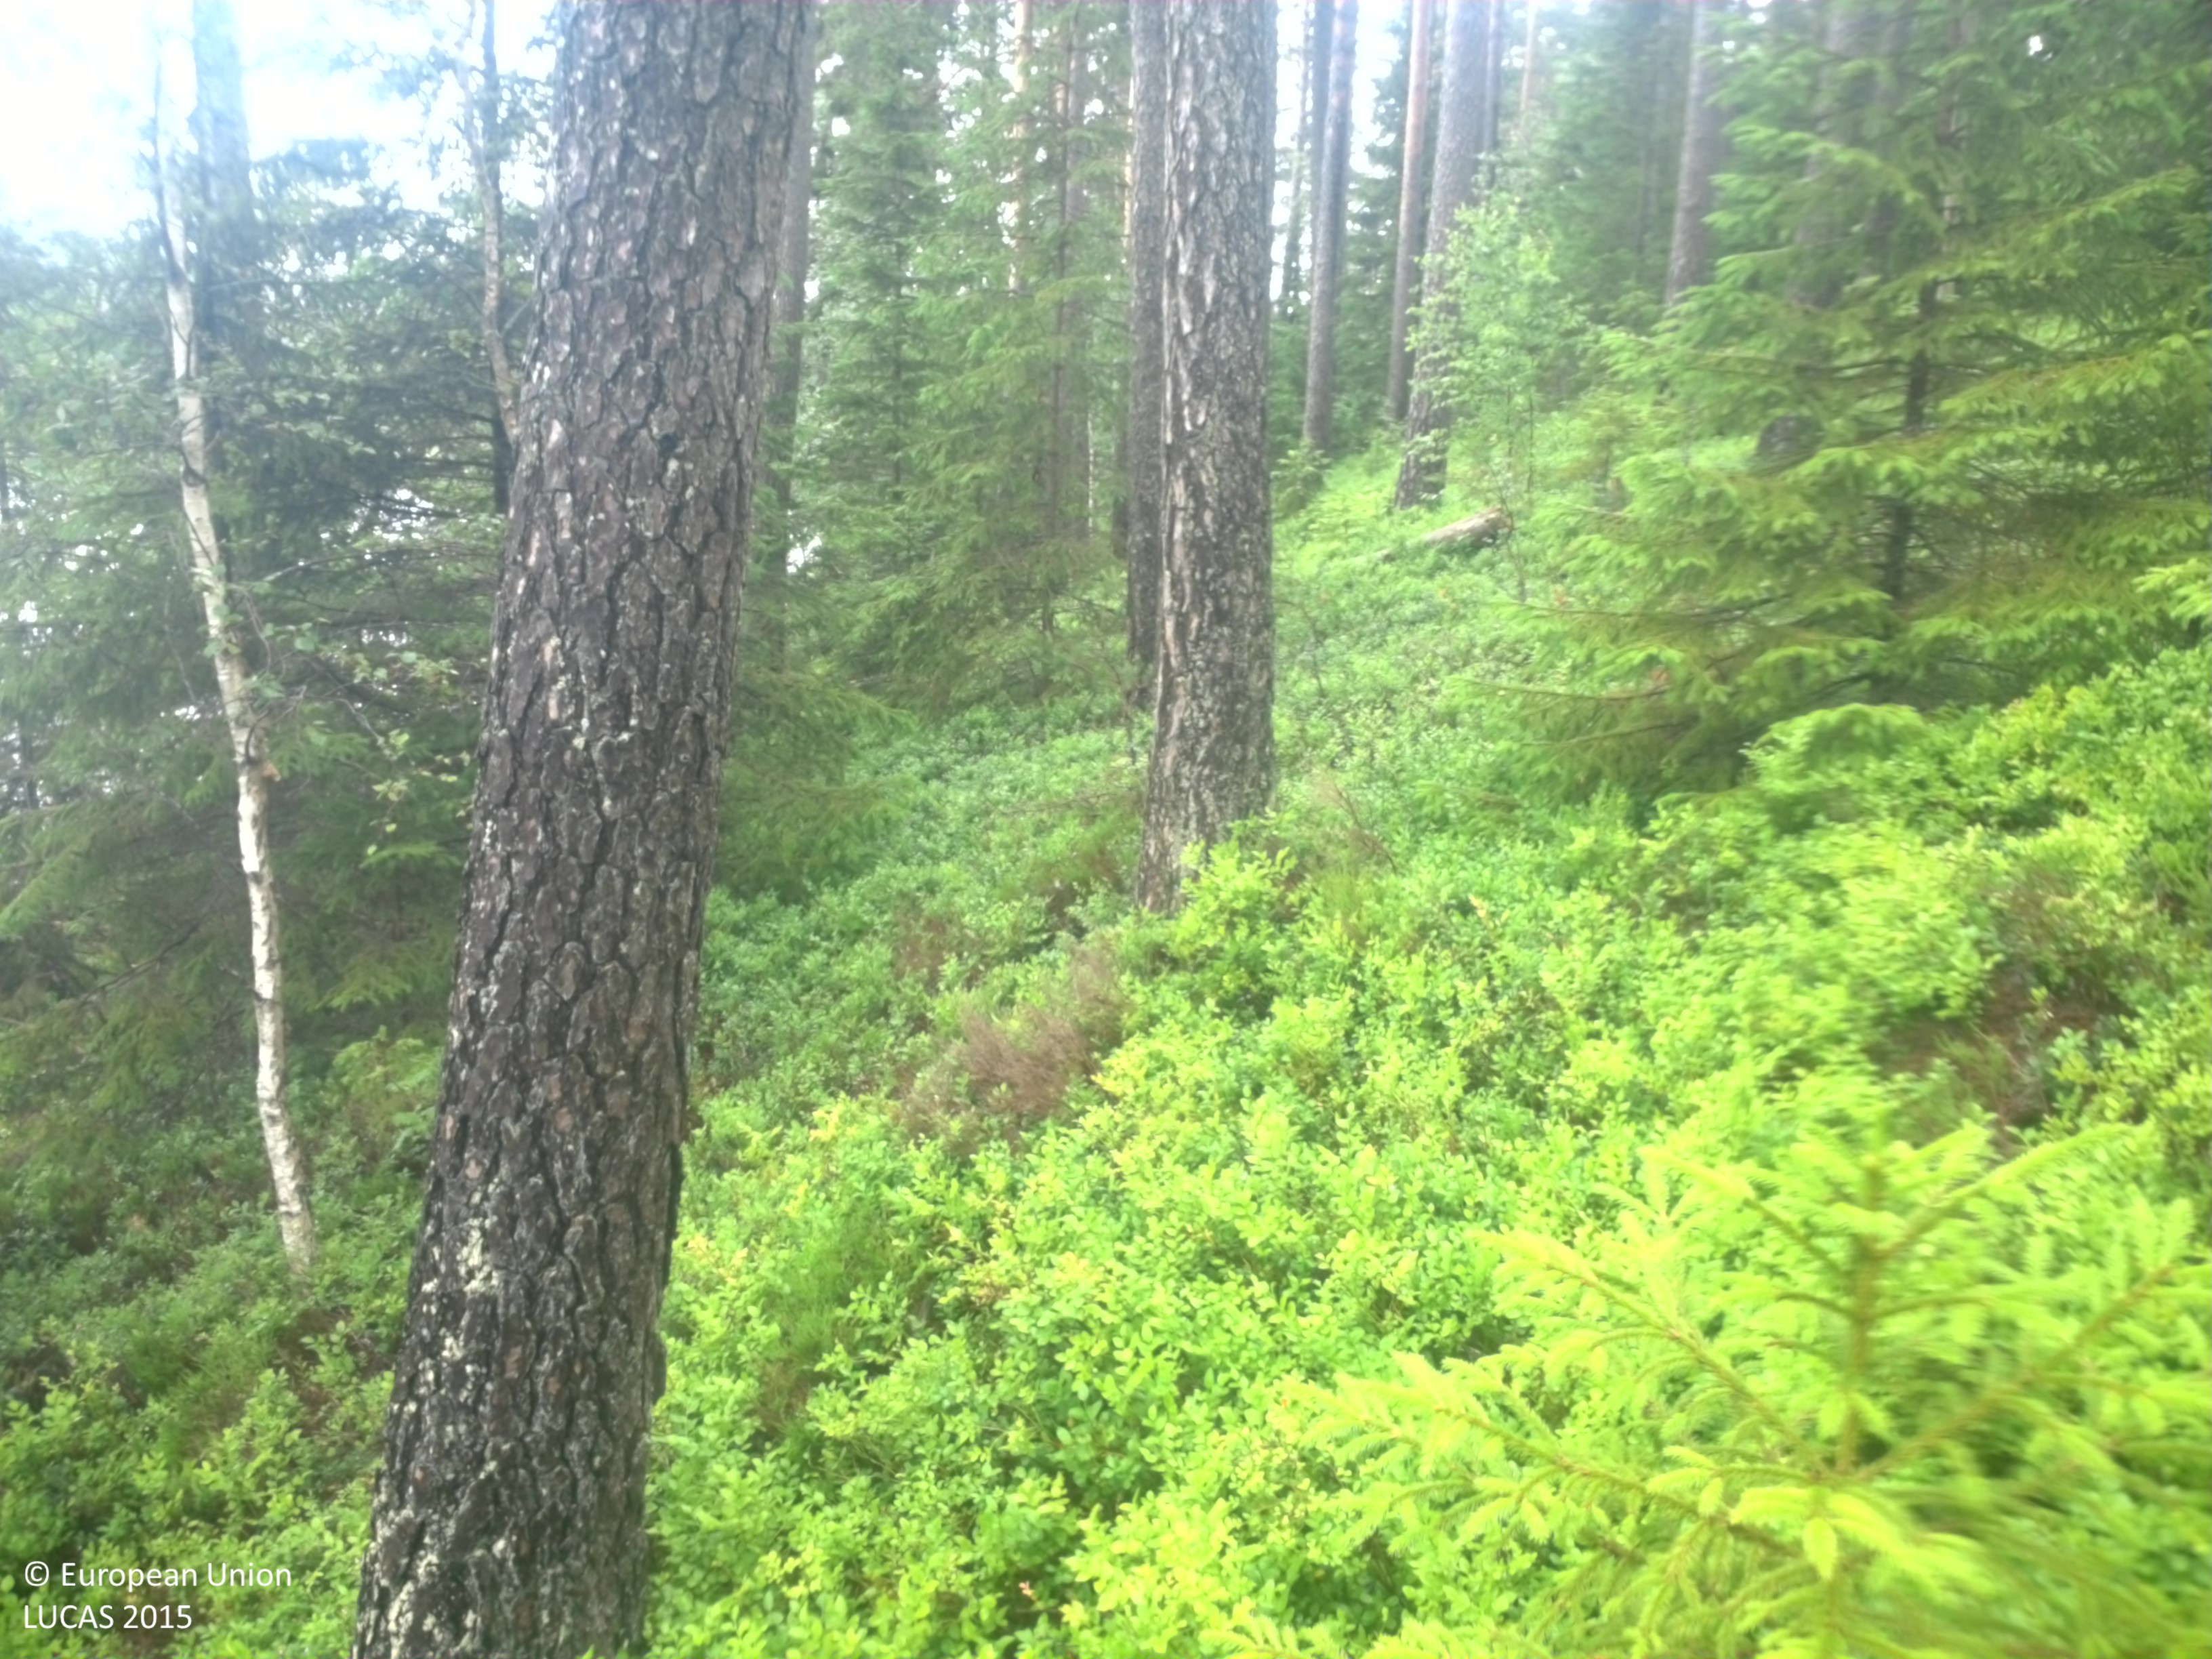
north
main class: Woodland
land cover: Pine dominated coniferous woodland
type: boreal forest
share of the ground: 50 - 75 %
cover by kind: coniferous forest trees 55 %, shrubs 35 %, broadleaved forest trees 5 %, lichens and mosses 5 %
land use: Forestry
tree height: > 5 m
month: July
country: SE
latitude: 59.6408
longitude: 14.4784
